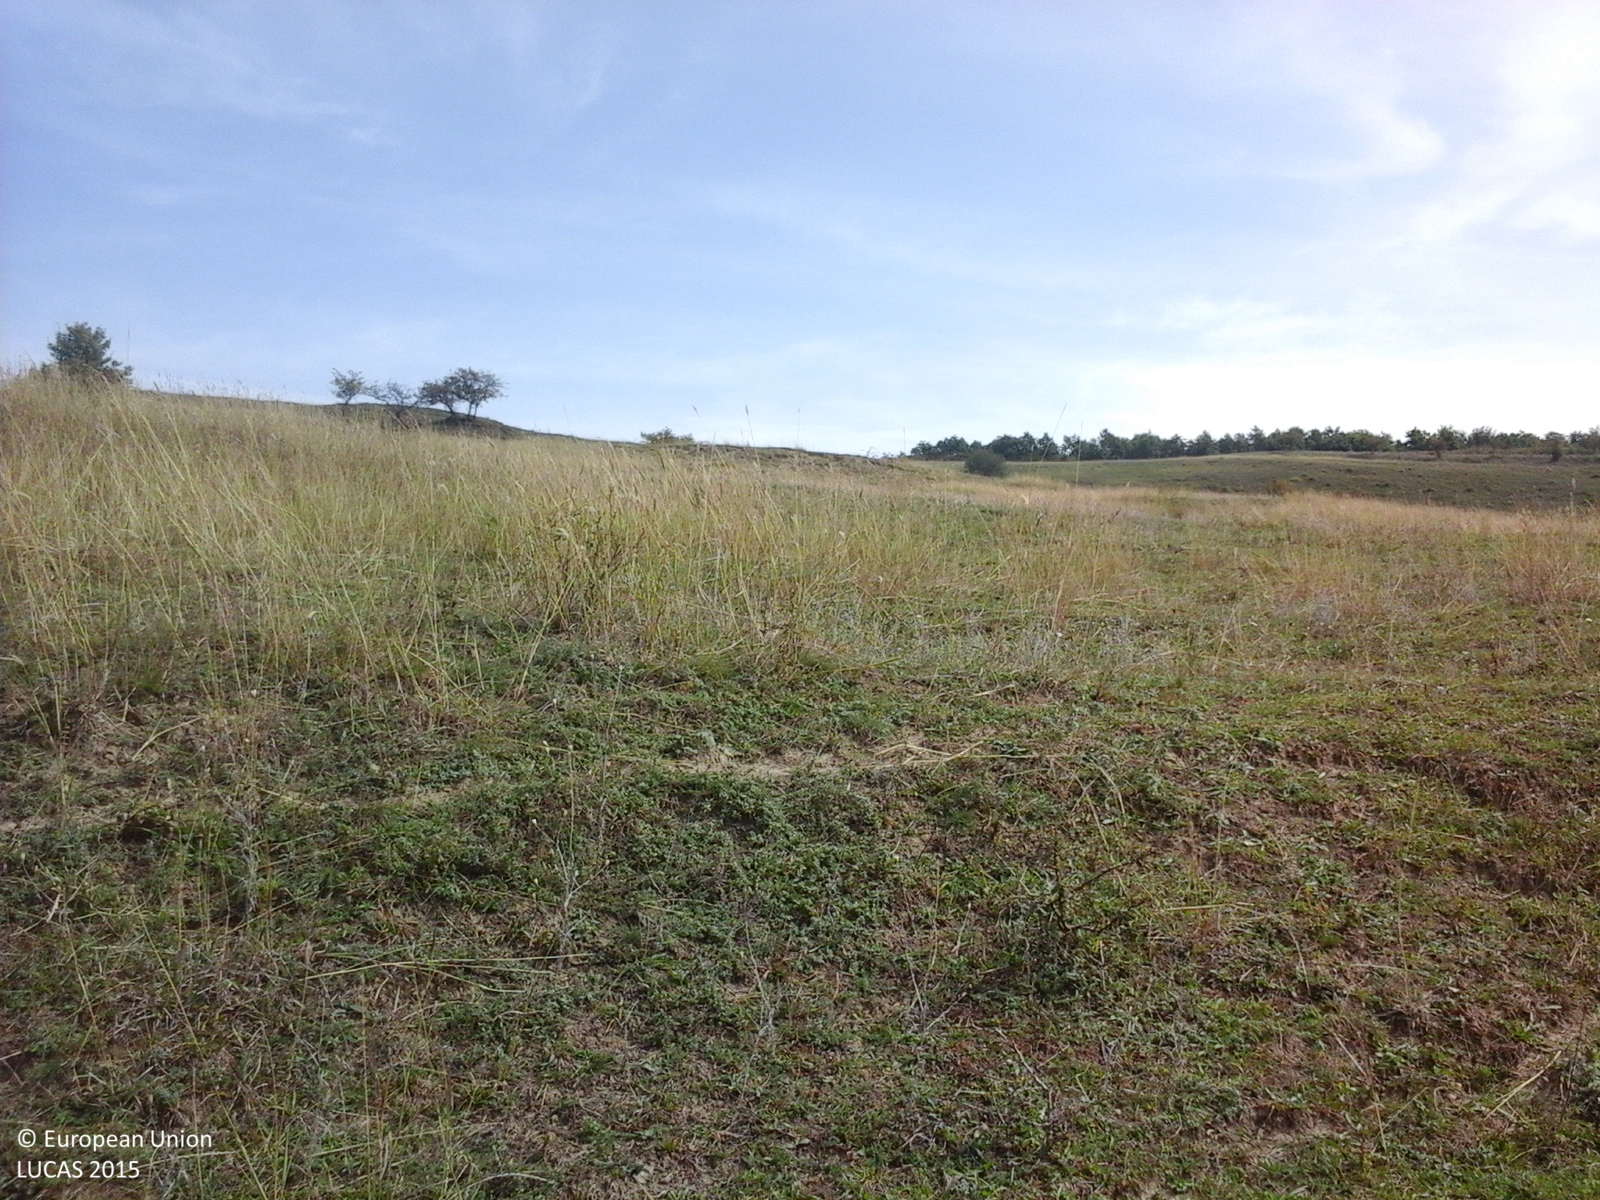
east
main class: Grassland
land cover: Grassland without tree/shrub cover
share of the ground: > 75 %
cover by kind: herbaceous plants 100 %
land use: Agriculture (excluding fallow land and kitchen gardens)
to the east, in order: Grassland without tree/shrub cover; Tracks; Grassland without tree/shrub cover
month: September
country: RO
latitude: 46.8762
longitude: 24.2148
